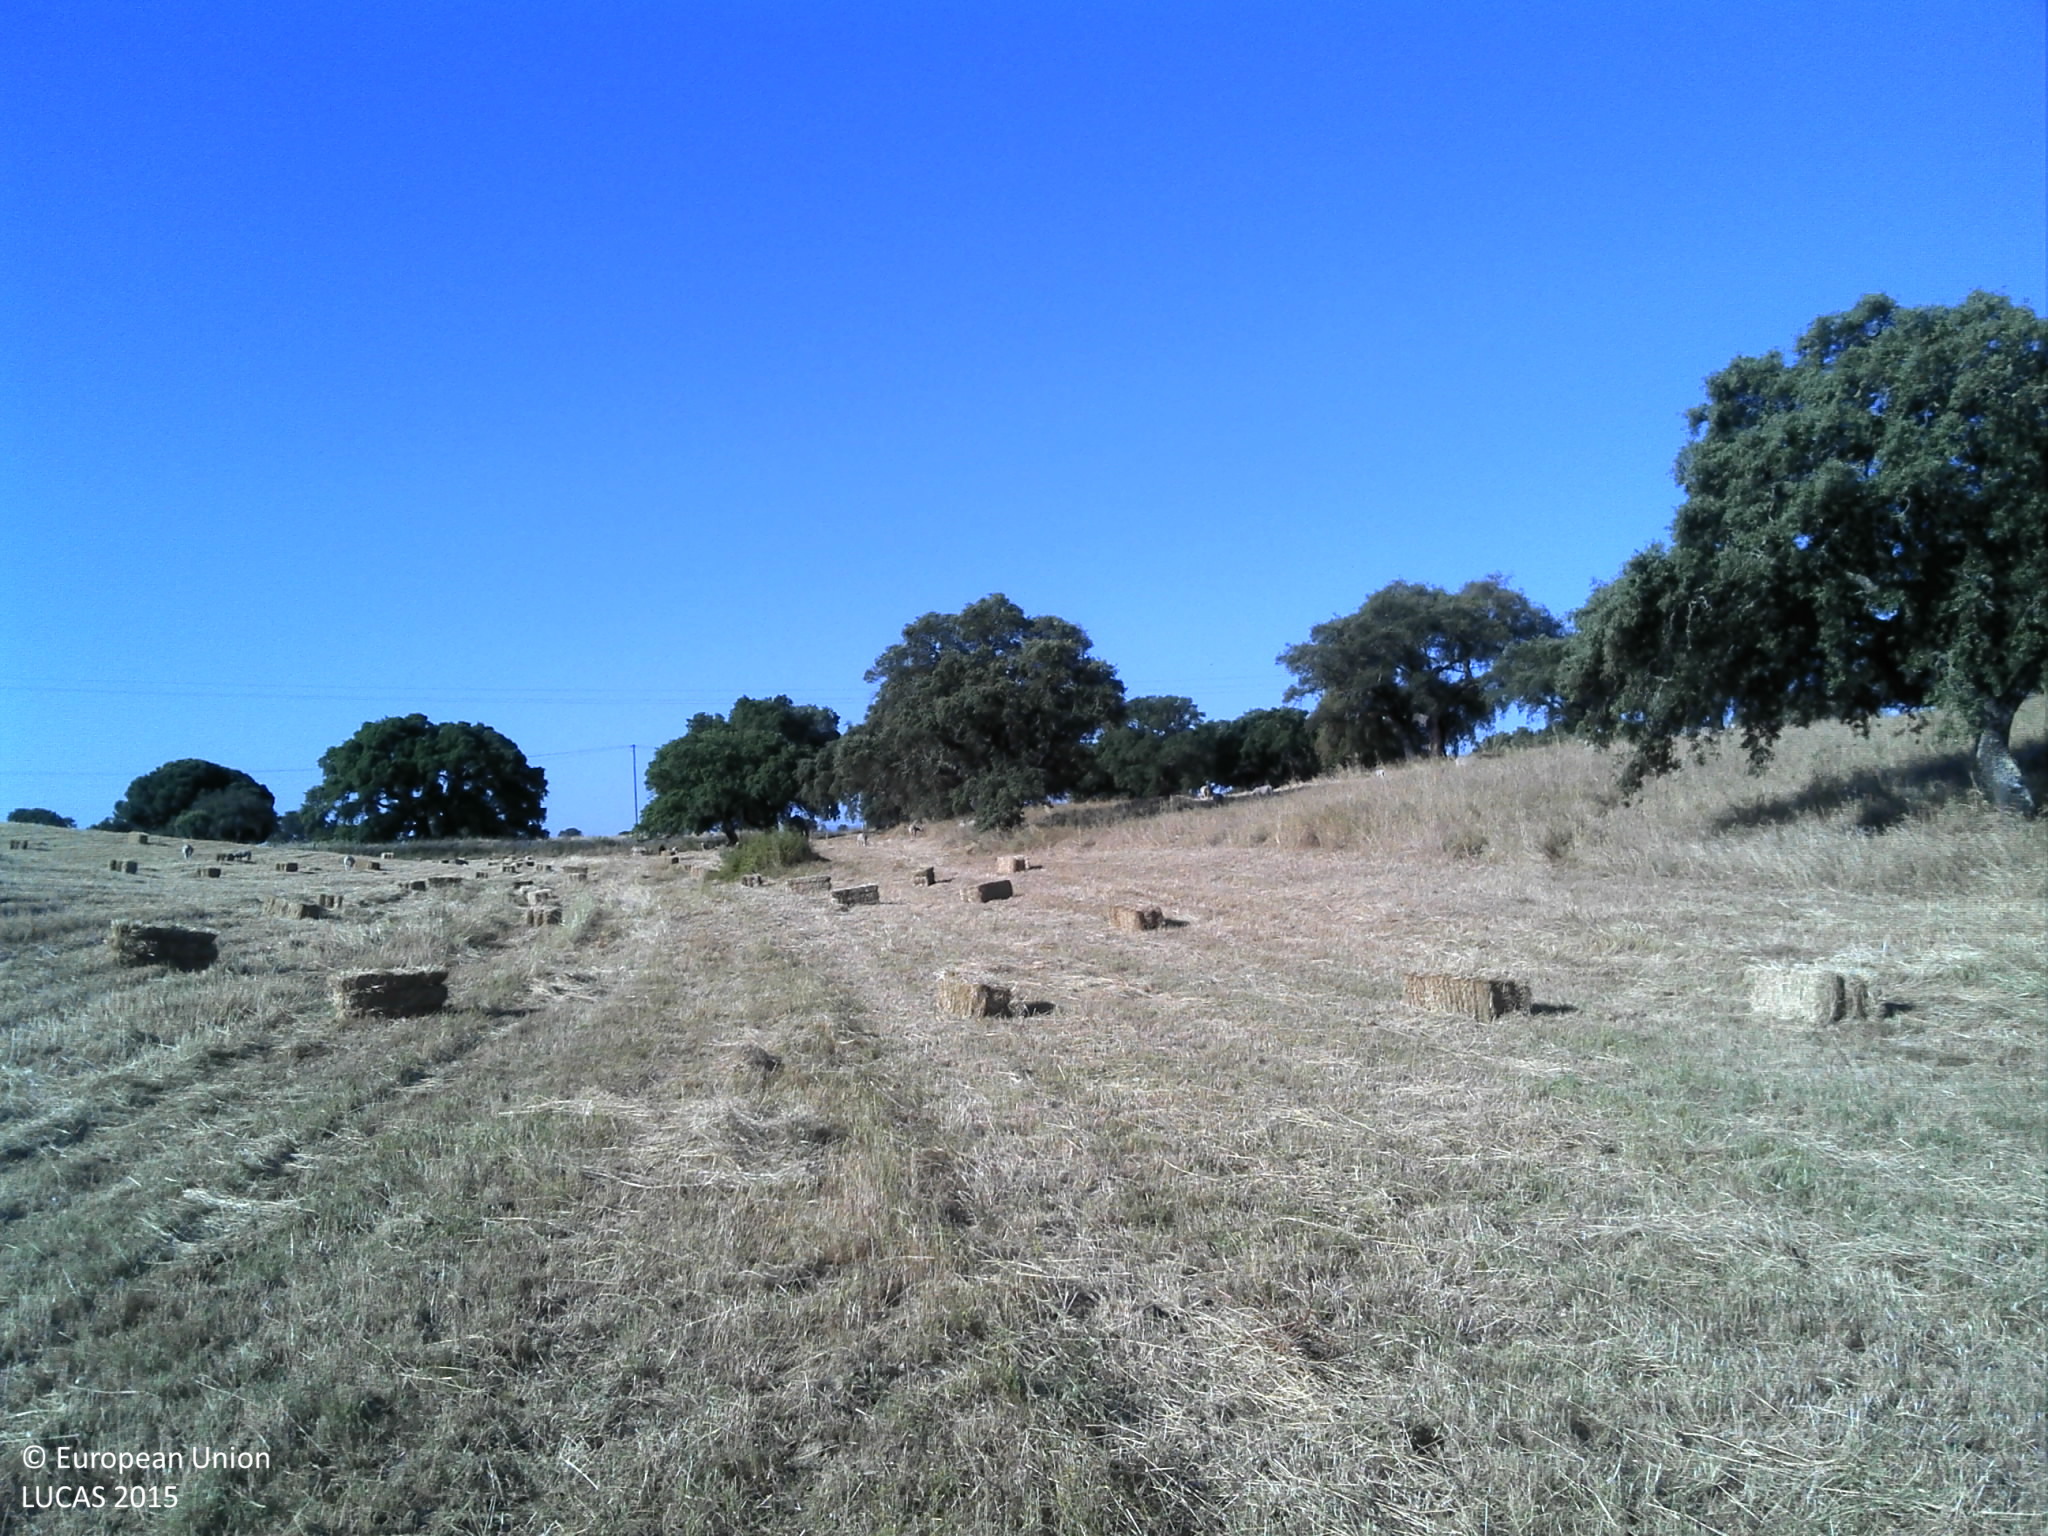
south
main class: Cropland
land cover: Other leguminous and mixtures for fodder
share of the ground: 50 - 75 %
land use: Agriculture (excluding fallow land and kitchen gardens)
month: May
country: PT
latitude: 38.1001
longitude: -8.4139
